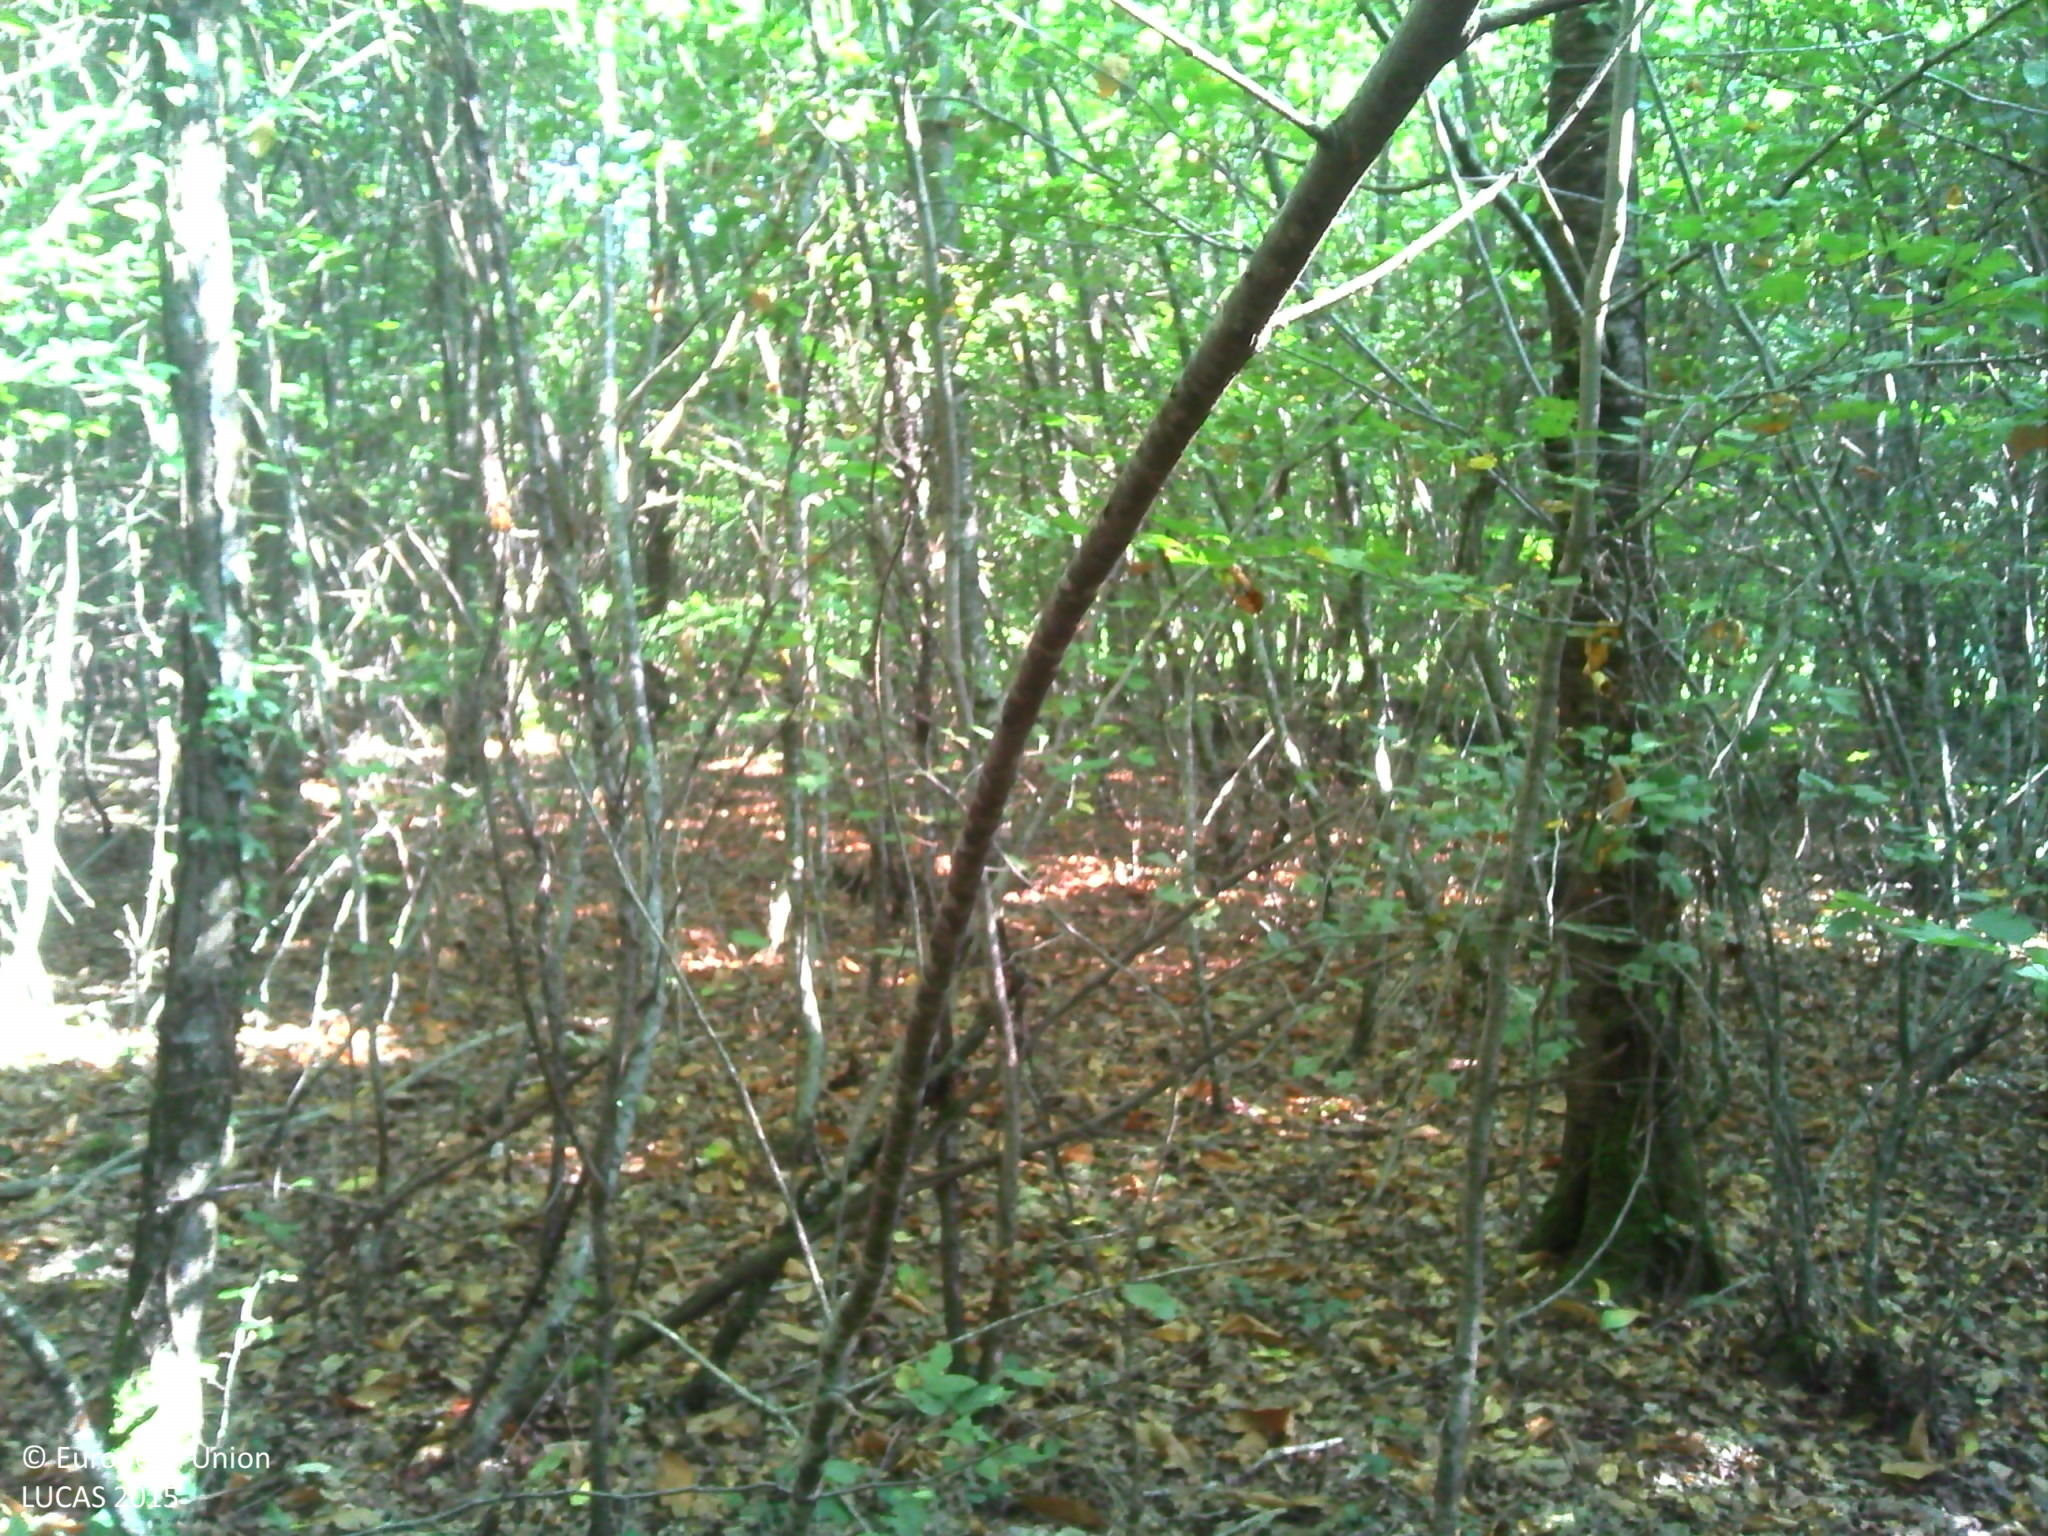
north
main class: Woodland
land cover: Broadleaved woodland
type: mesophytic deciduous forest
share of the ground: > 75 %
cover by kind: broadleaved forest trees 95 %, unconsolidated bare surface 5 %
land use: Forestry
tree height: > 5 m
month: September
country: FR
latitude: 47.0400
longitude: 1.4459
